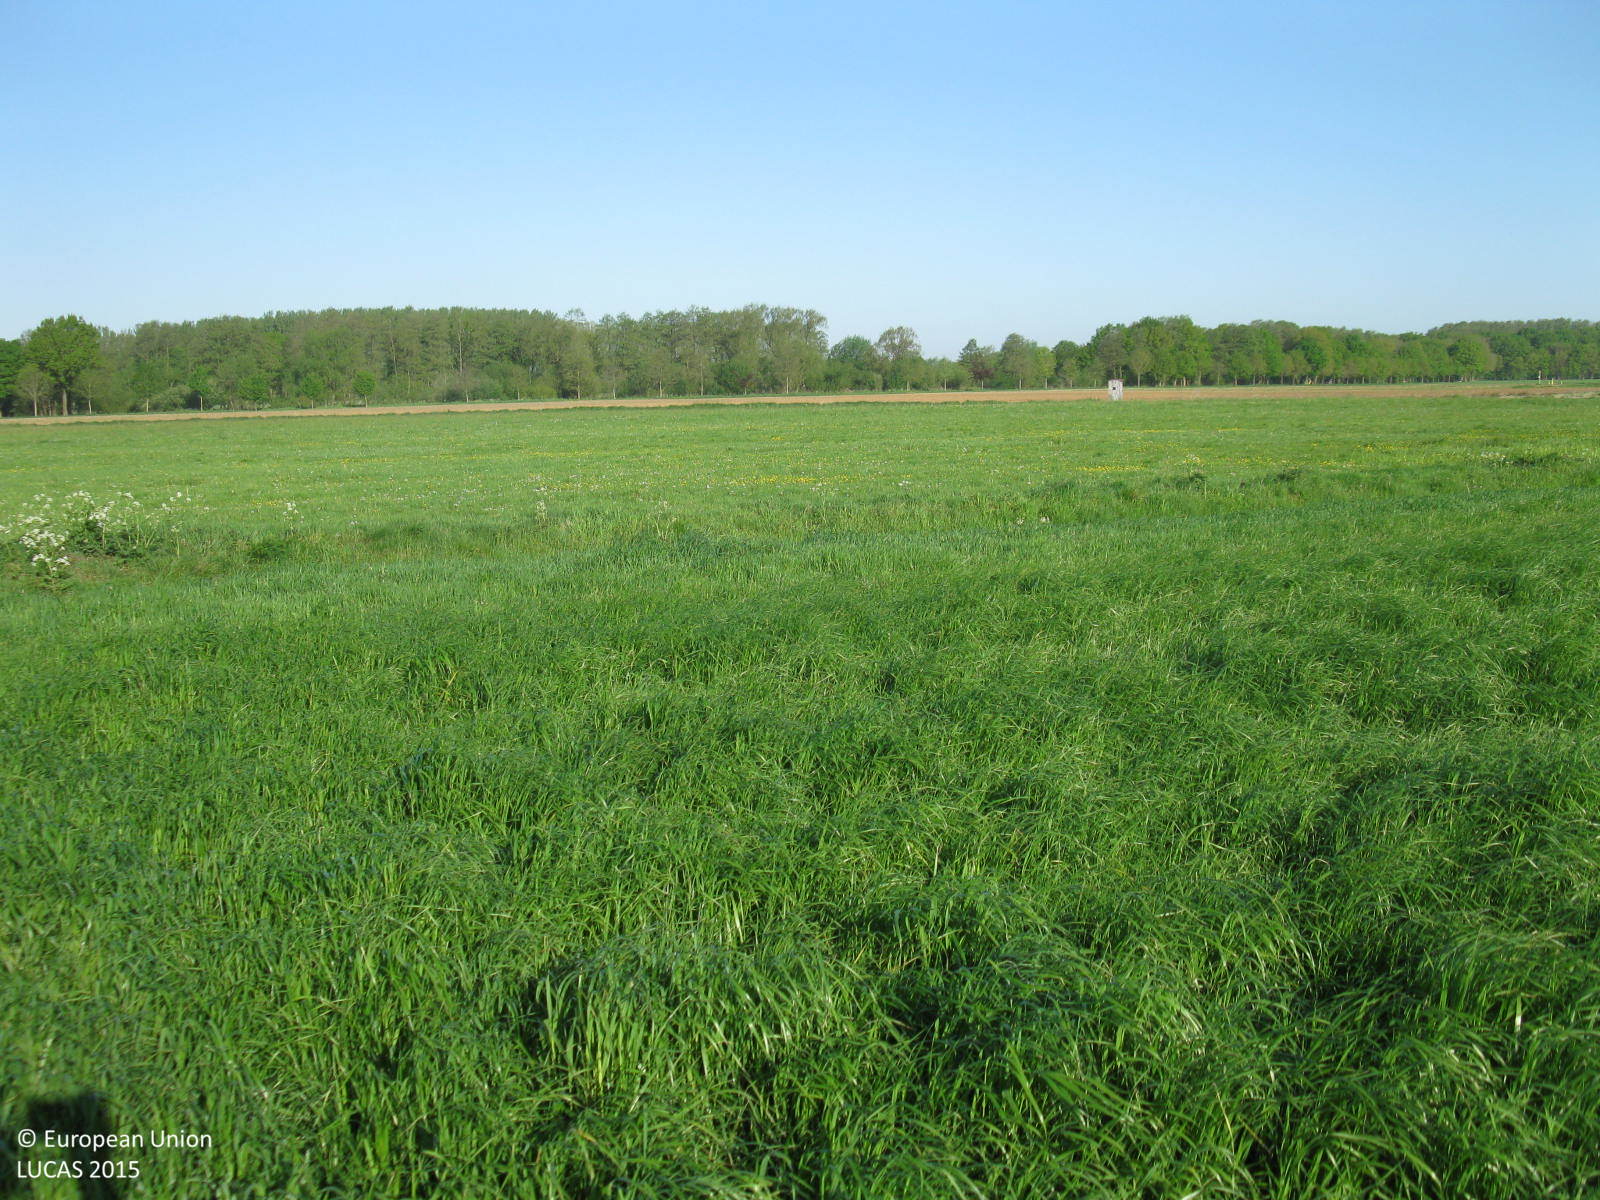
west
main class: Grassland
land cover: Grassland without tree/shrub cover
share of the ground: > 75 %
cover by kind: herbaceous plants 100 %
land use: Agriculture (excluding fallow land and kitchen gardens)
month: May
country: DE
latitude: 52.8506
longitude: 7.3127
